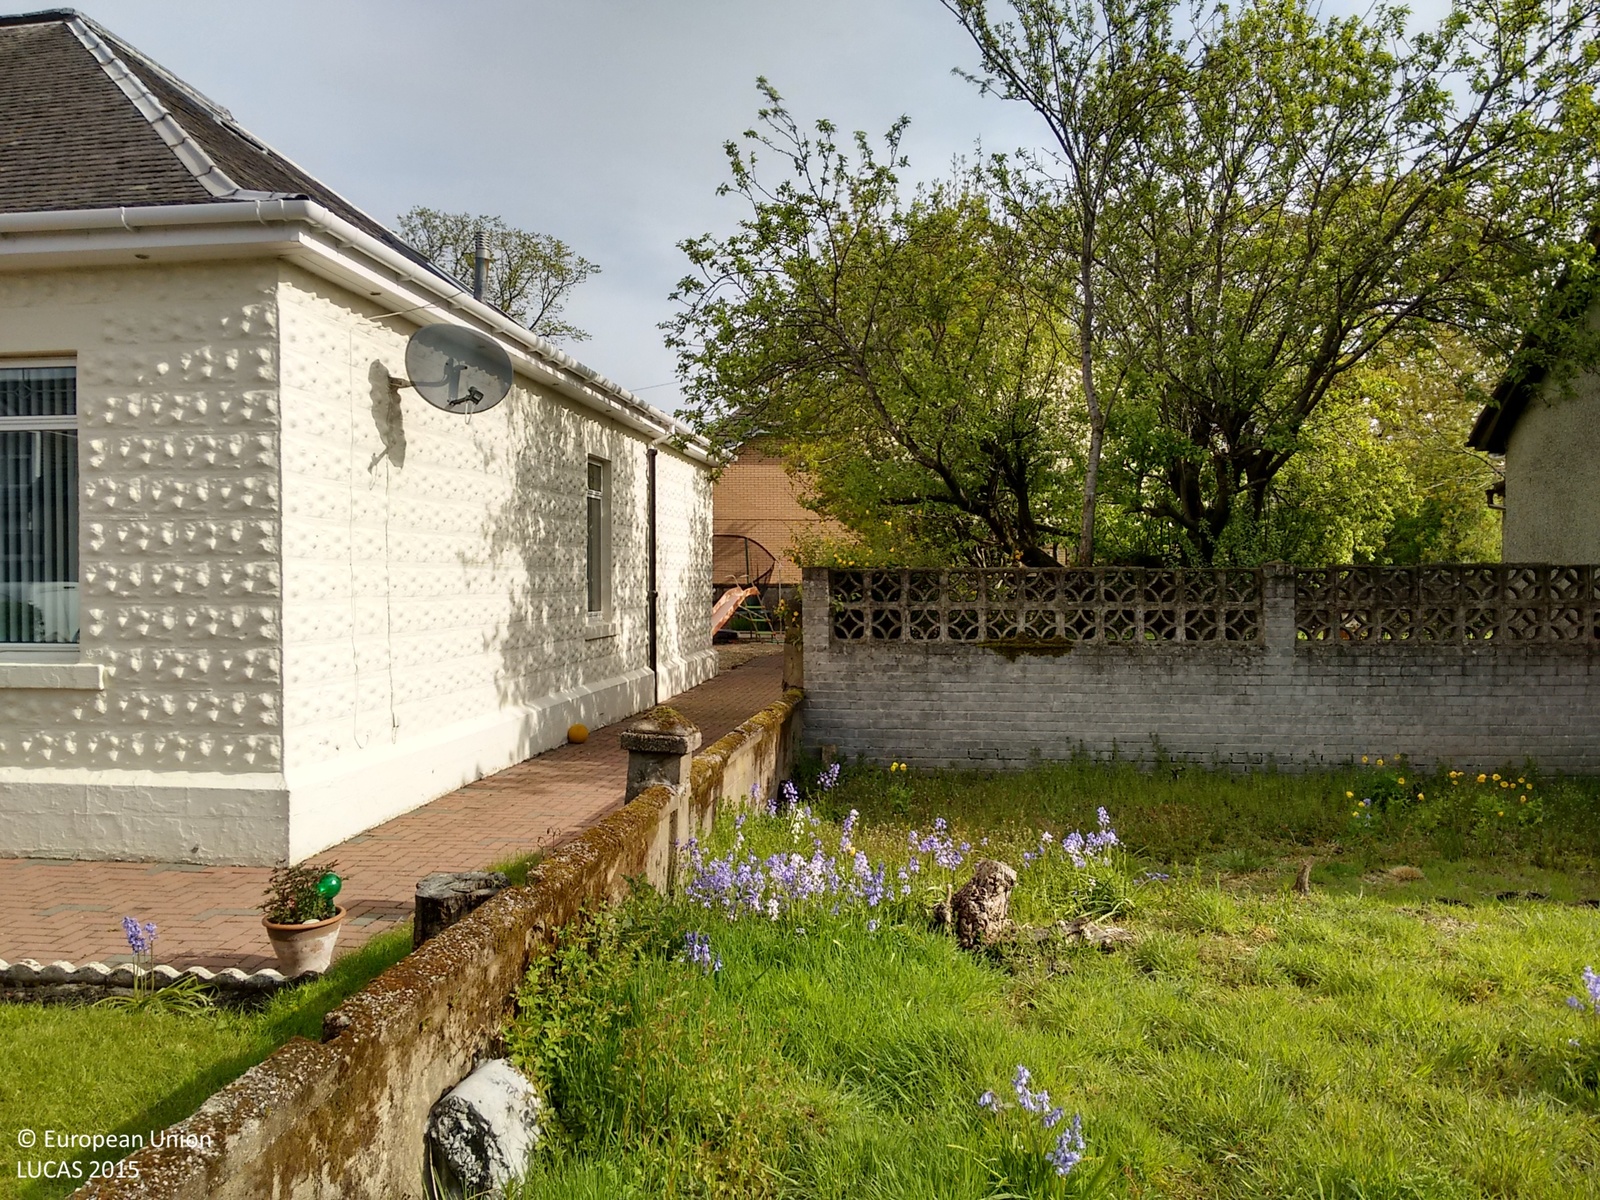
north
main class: Grassland
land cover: Grassland without tree/shrub cover
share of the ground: > 75 %
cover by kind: herbaceous plants 100 %
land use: Residential
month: May
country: GB
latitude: 55.8603
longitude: -4.4286
